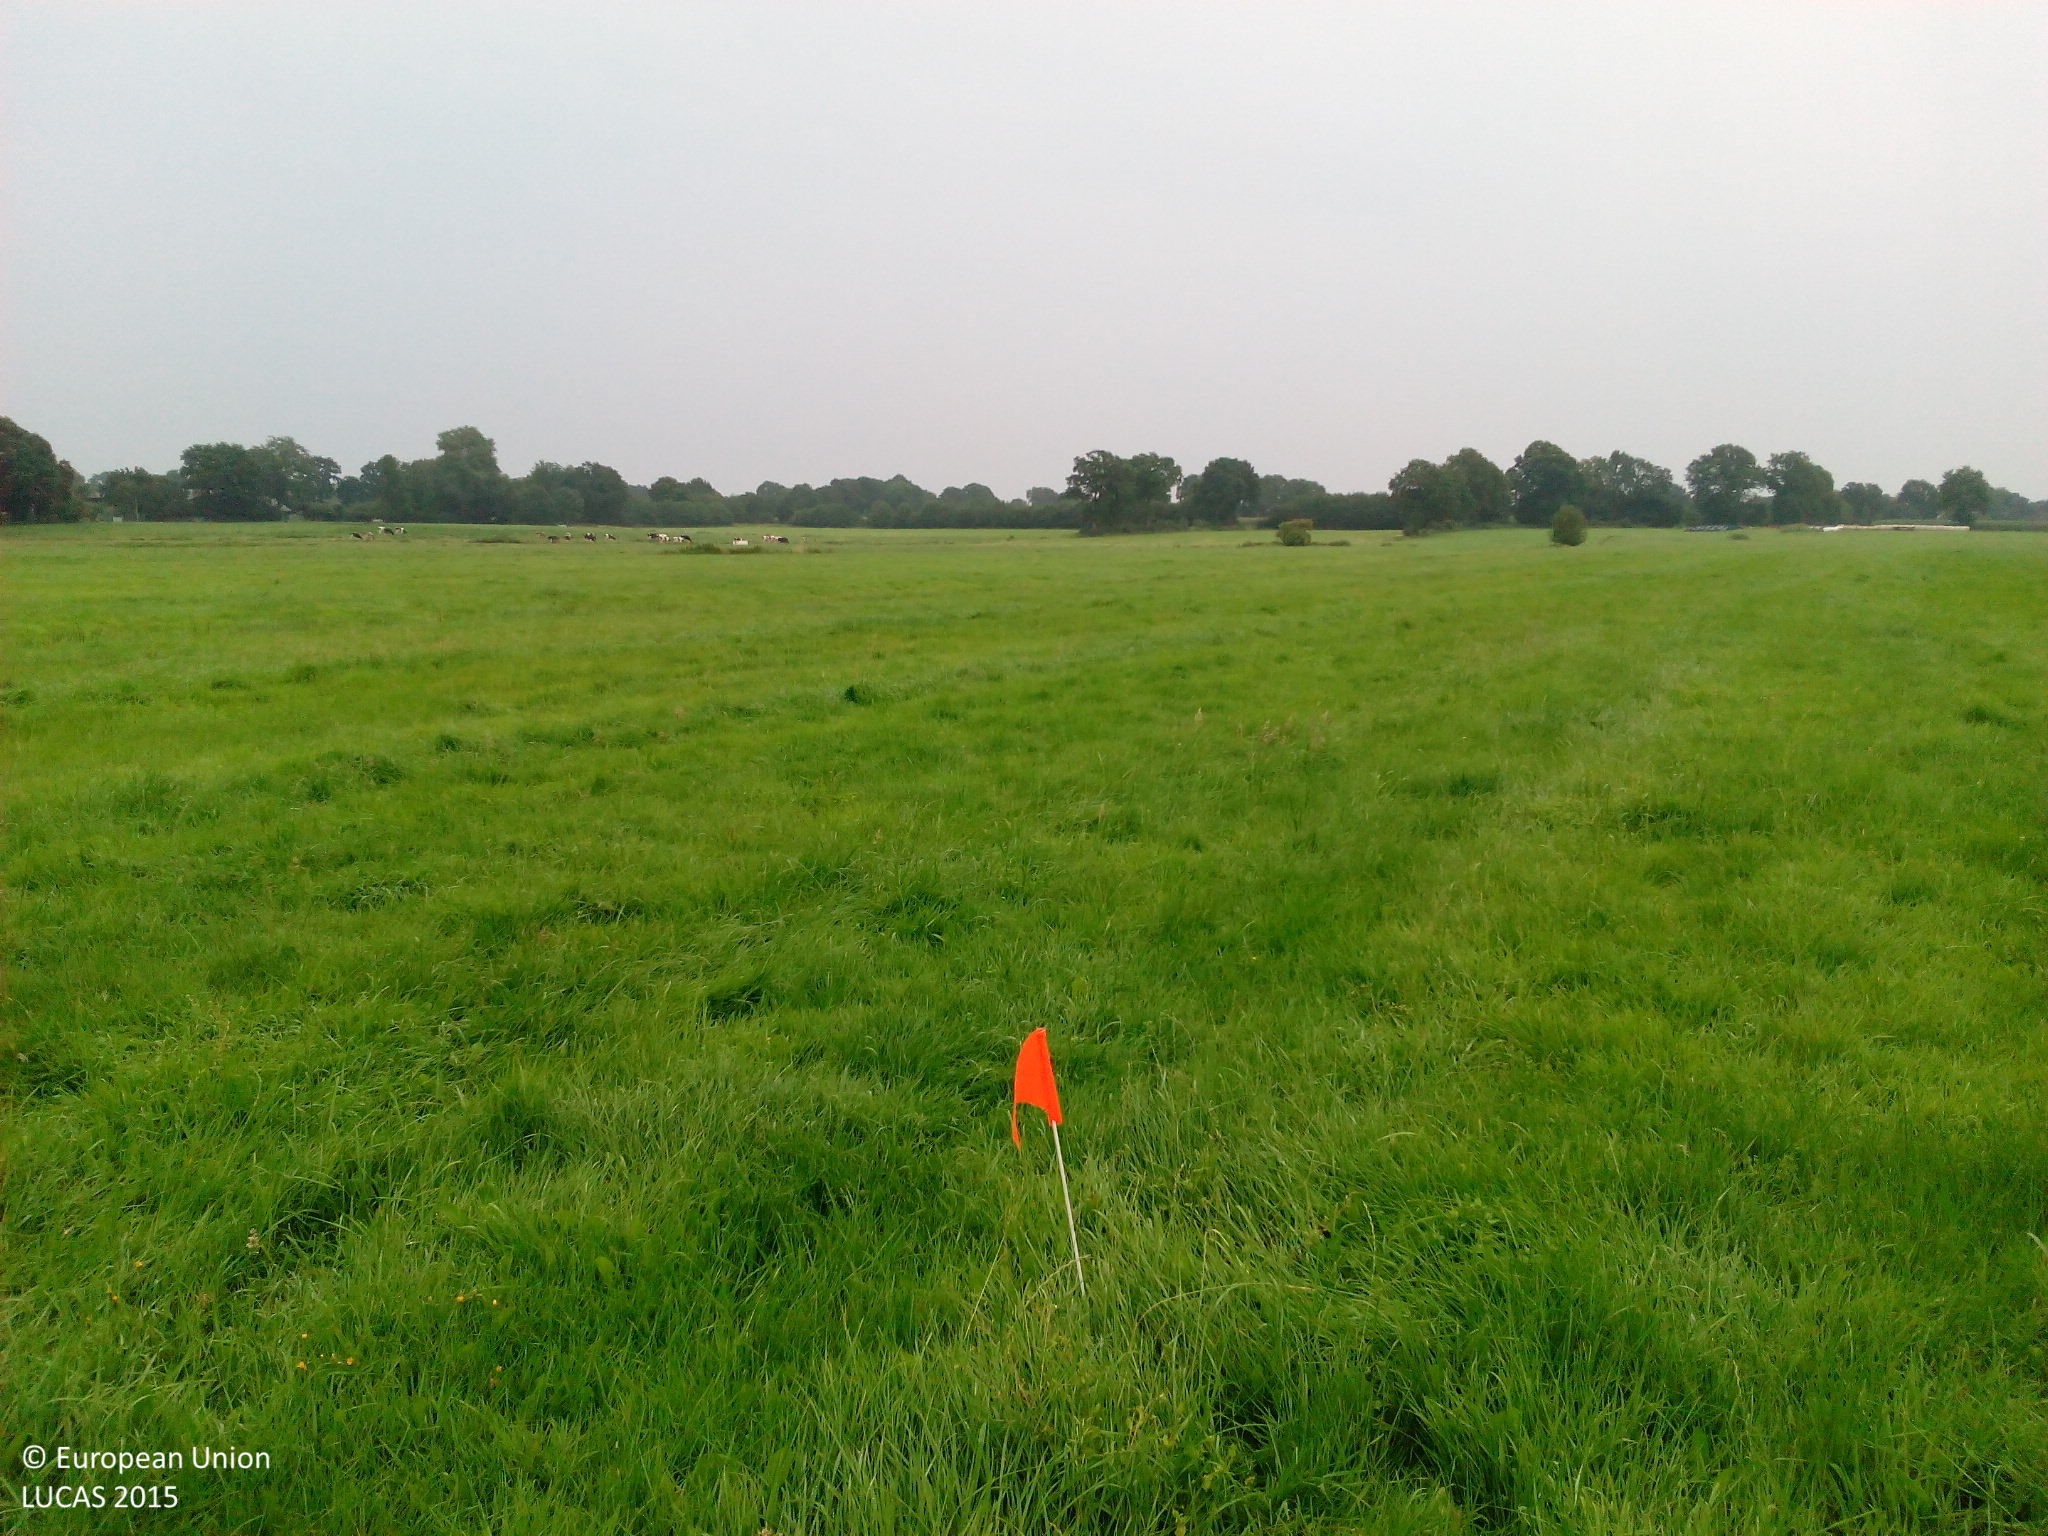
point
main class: Grassland
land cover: Grassland without tree/shrub cover
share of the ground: > 75 %
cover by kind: herbaceous plants 100 %
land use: Agriculture (excluding fallow land and kitchen gardens)
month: August
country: DE
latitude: 53.8687
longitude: 9.6504
